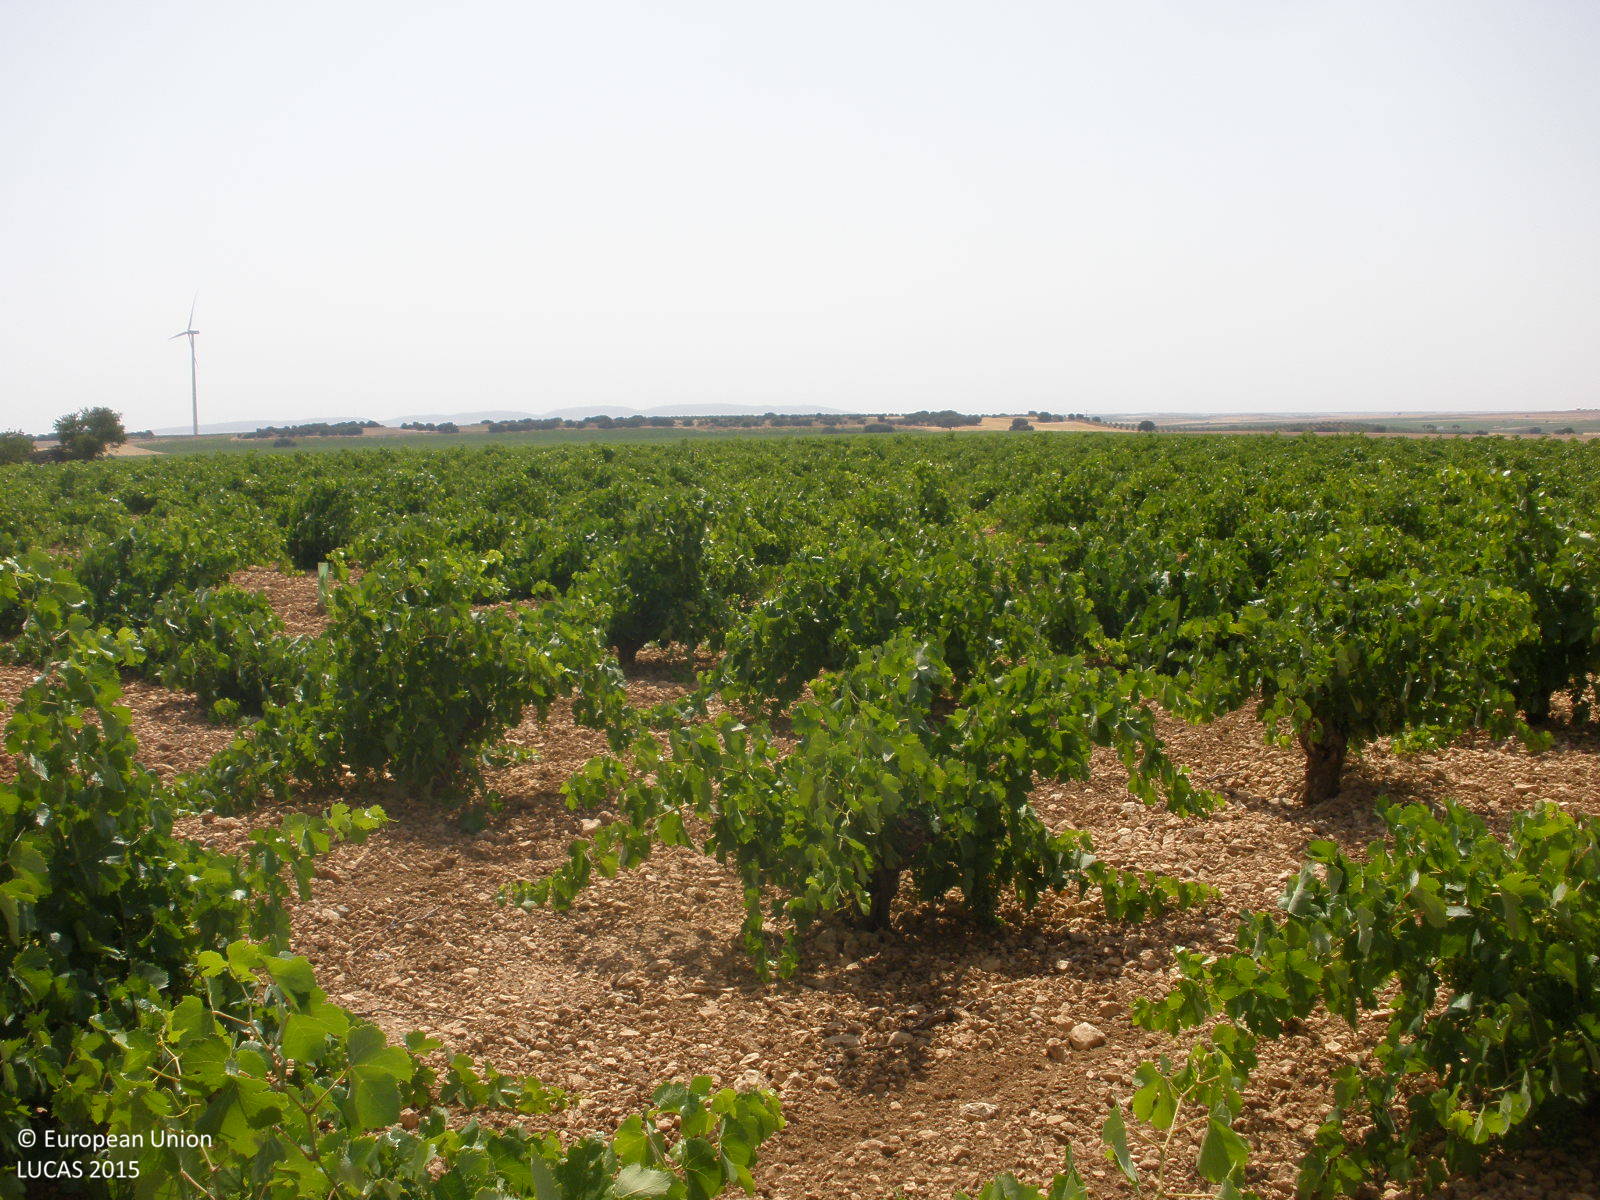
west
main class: Cropland
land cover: Vineyards
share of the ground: 50 - 75 %
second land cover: Other bare soil
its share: > 75 %
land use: Agriculture (excluding fallow land and kitchen gardens)
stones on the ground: > 50 %
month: July
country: ES
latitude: 39.6991
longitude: -3.2121
